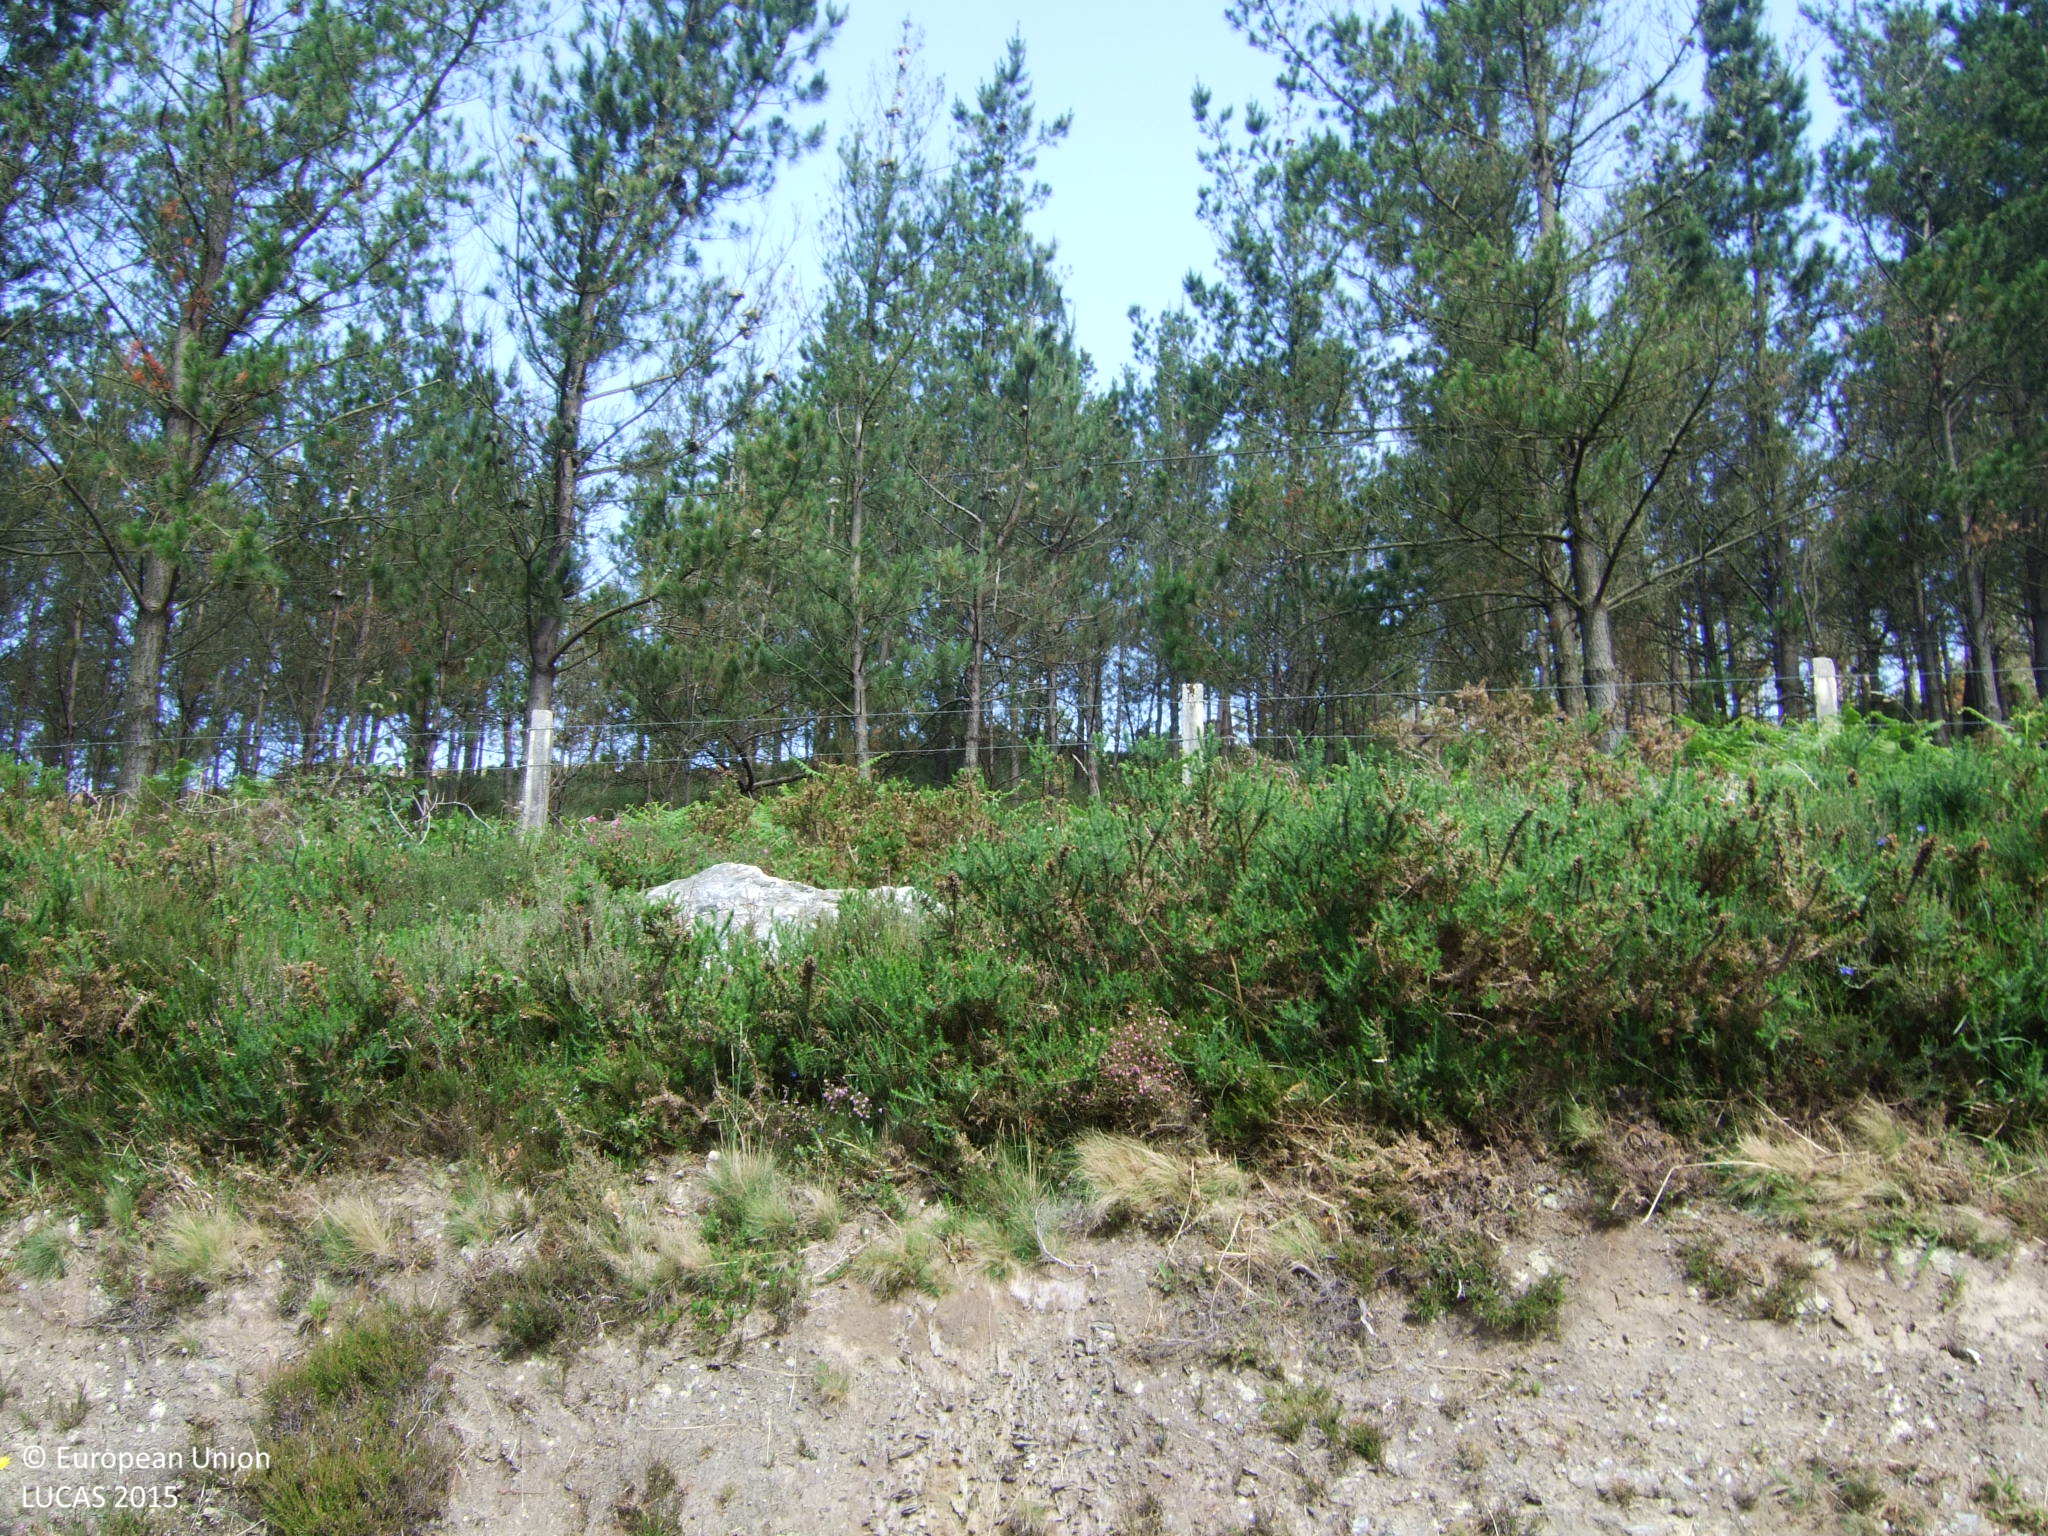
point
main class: Woodland
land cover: Pine dominated coniferous woodland
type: exotic forest
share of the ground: 50 - 75 %
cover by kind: coniferous forest trees 70 %, shrubs 30 %
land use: Forestry
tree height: > 5 m
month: June
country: ES
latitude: 43.4906
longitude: -7.8357
